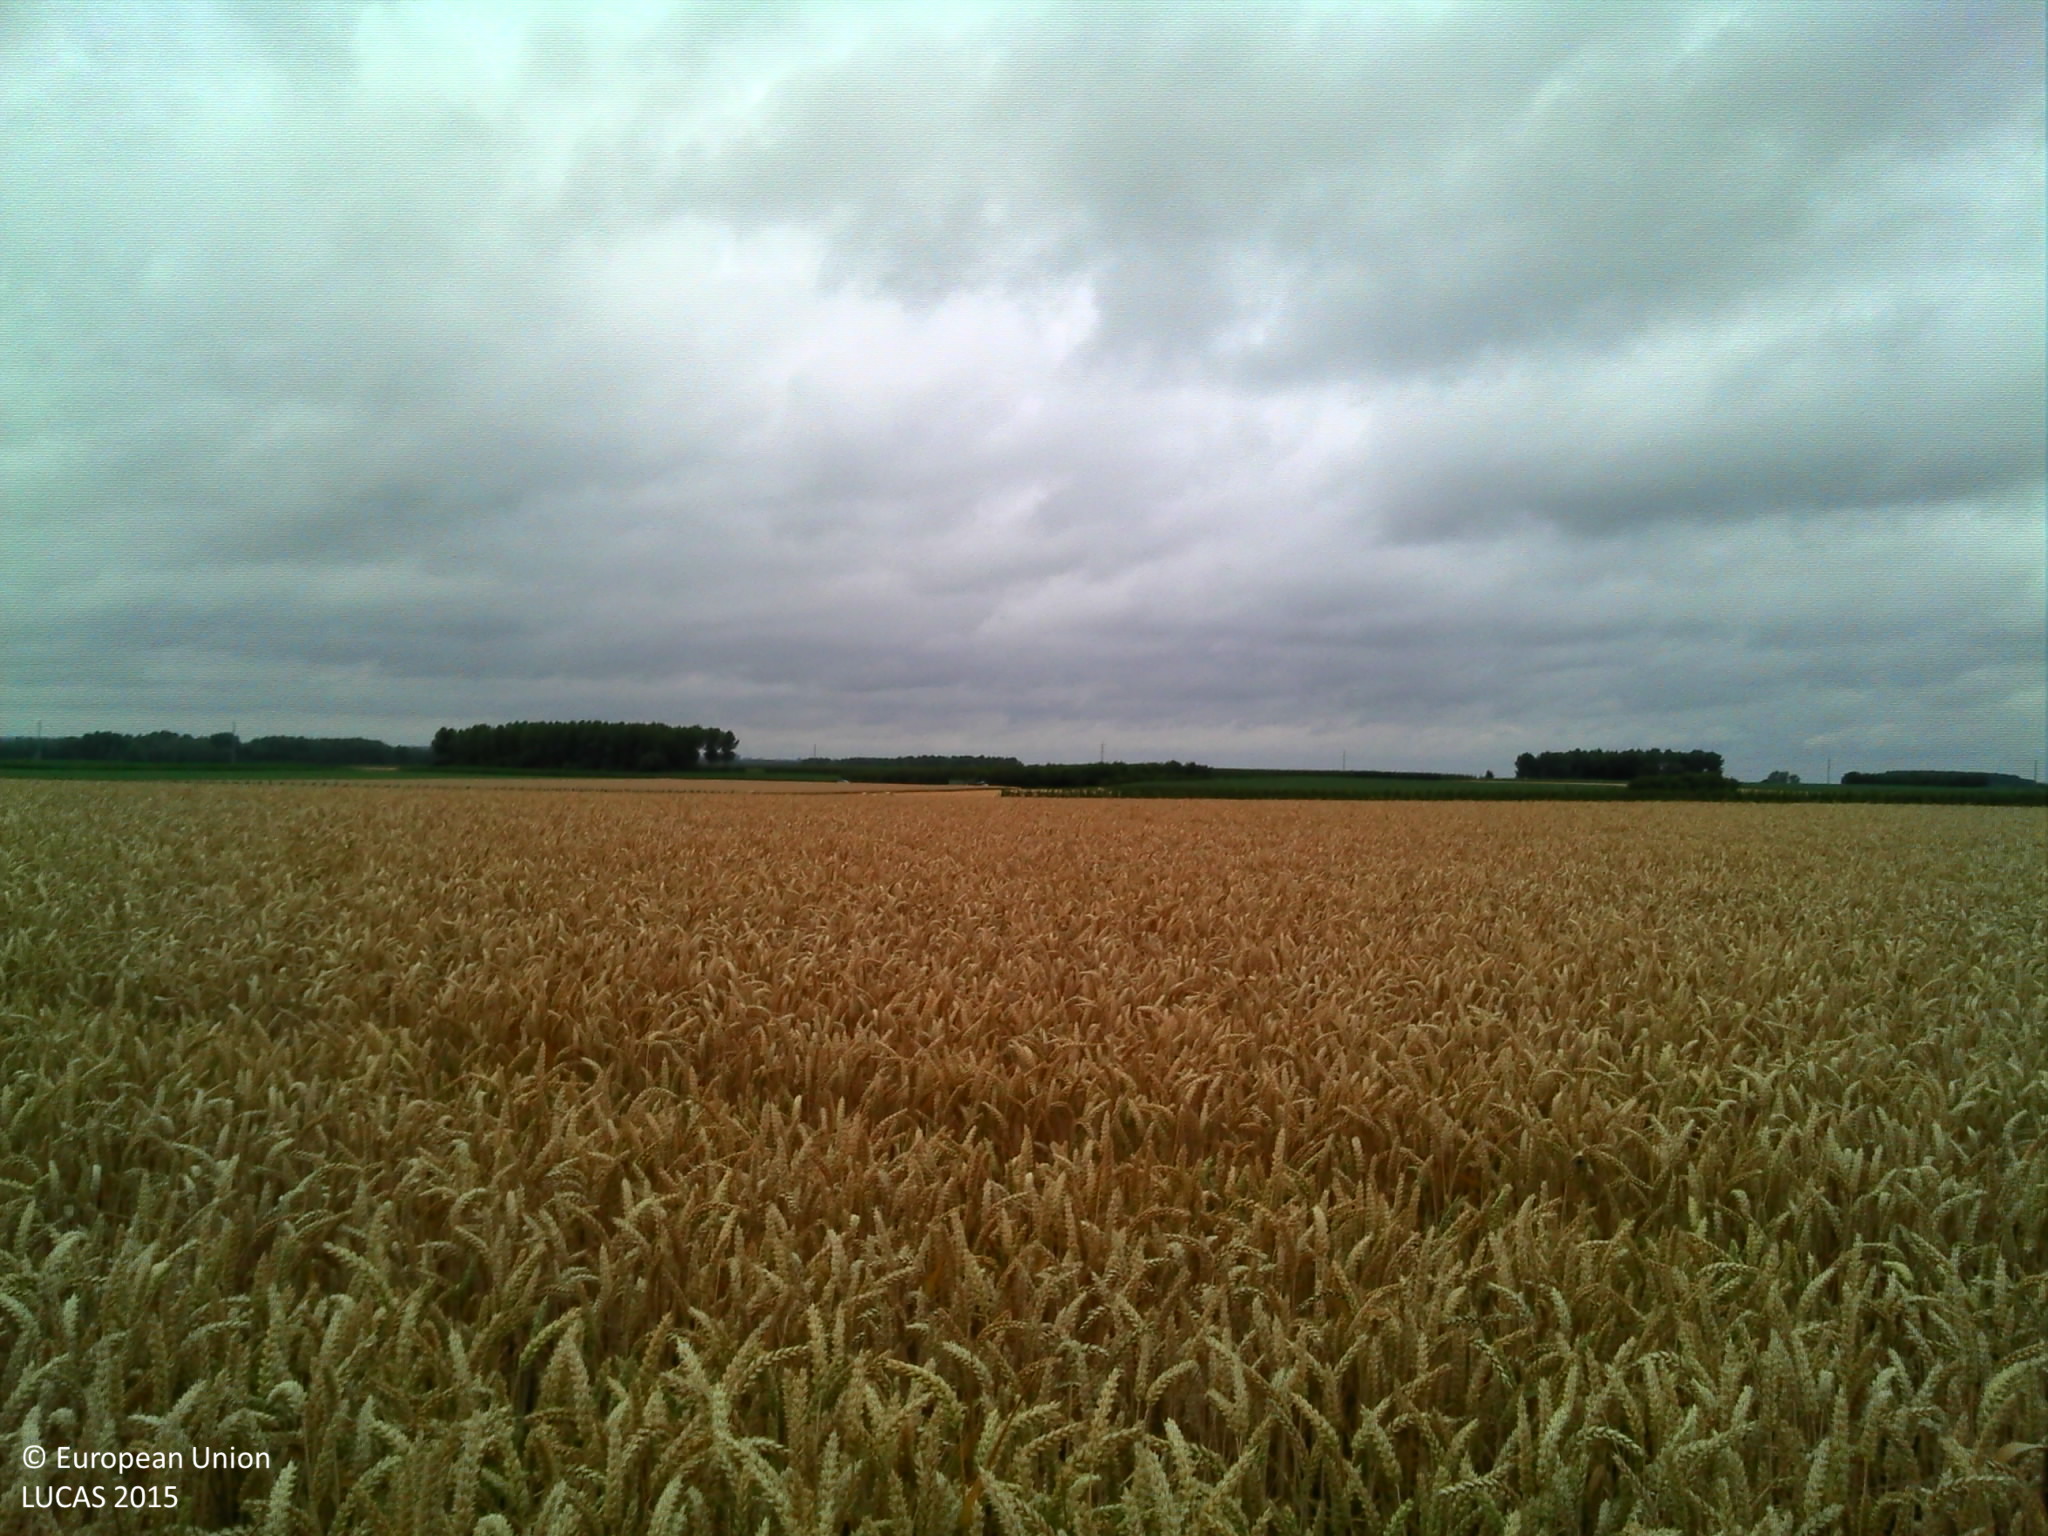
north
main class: Cropland
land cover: Common wheat
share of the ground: > 75 %
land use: Agriculture (excluding fallow land and kitchen gardens)
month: July
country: BE
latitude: 50.7817
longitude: 5.1042
